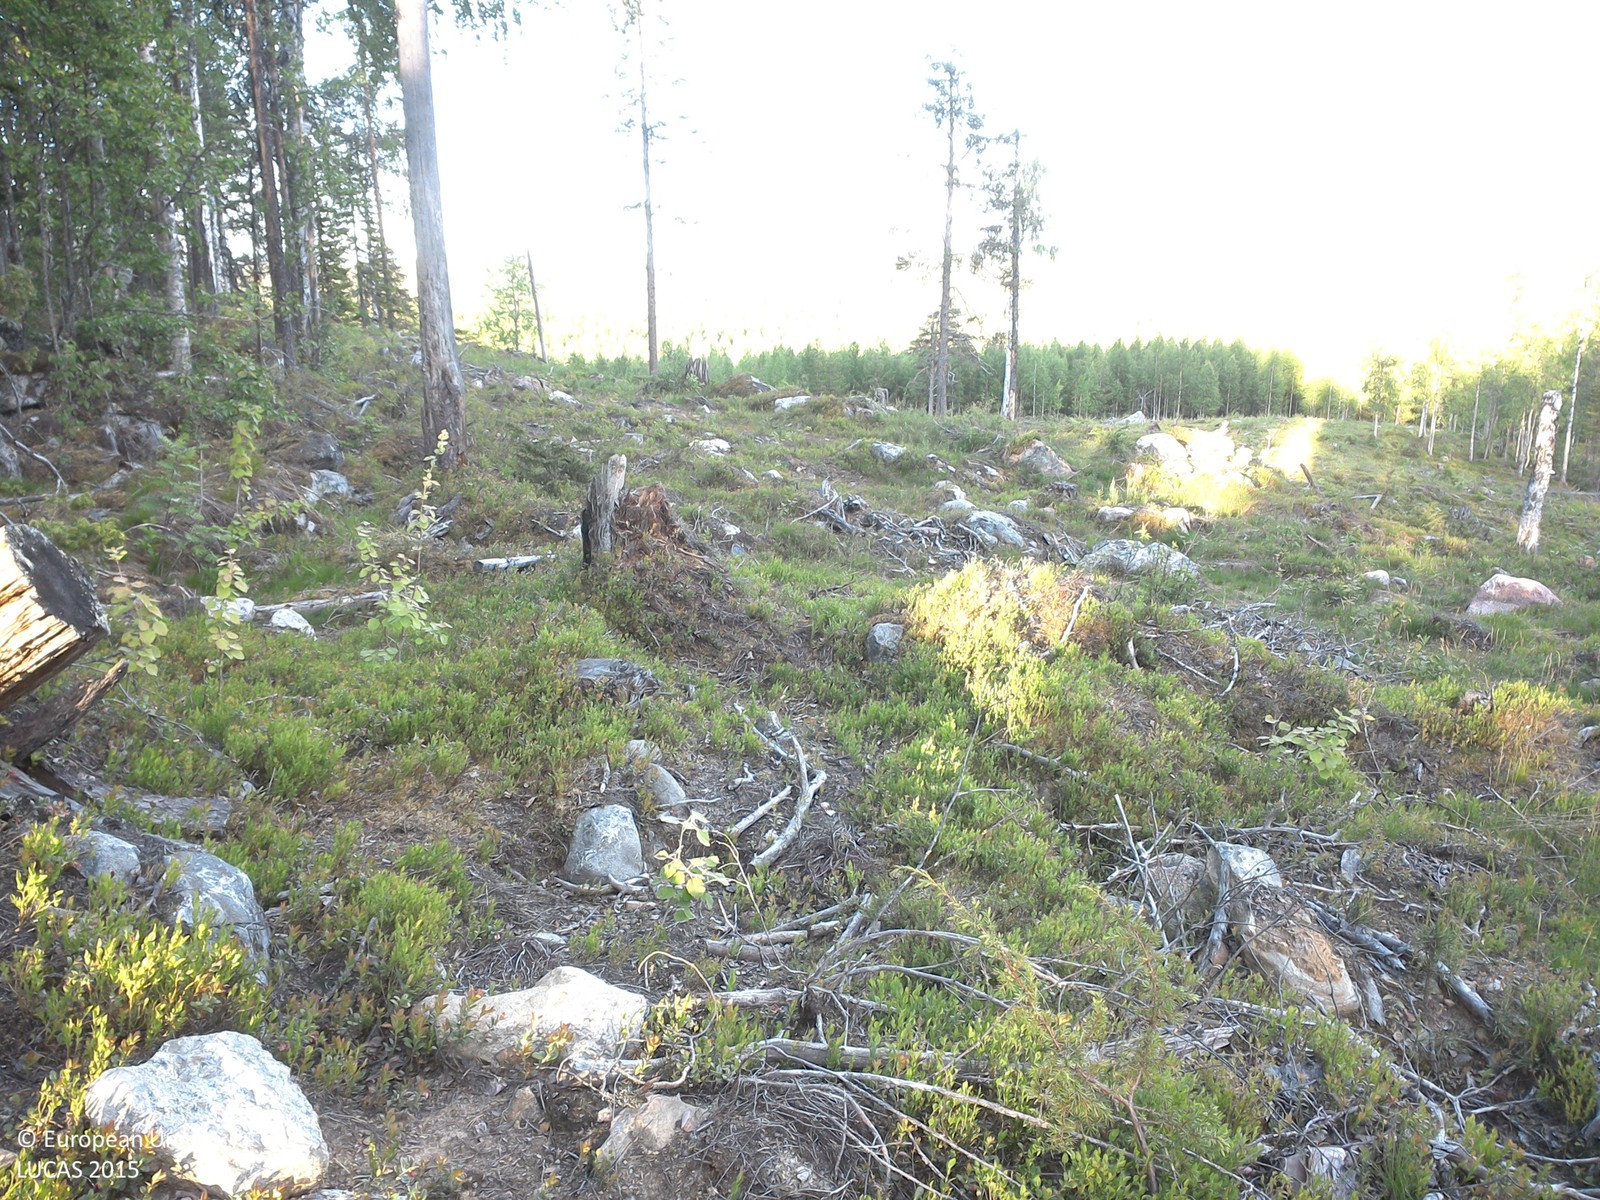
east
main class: Shrubland
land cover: Shrubland with sparse tree cover
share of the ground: 50 - 75 %
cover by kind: shrubs 50 %, unconsolidated bare surface 30 %, herbaceous plants 15 %, broadleaved forest trees 5 %
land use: Forestry
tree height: < 5 m
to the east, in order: Shrubland with sparse tree cover; Broadleaved woodland; Pine dominated mixed woodland
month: June
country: SE
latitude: 66.7515
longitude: 22.9367
